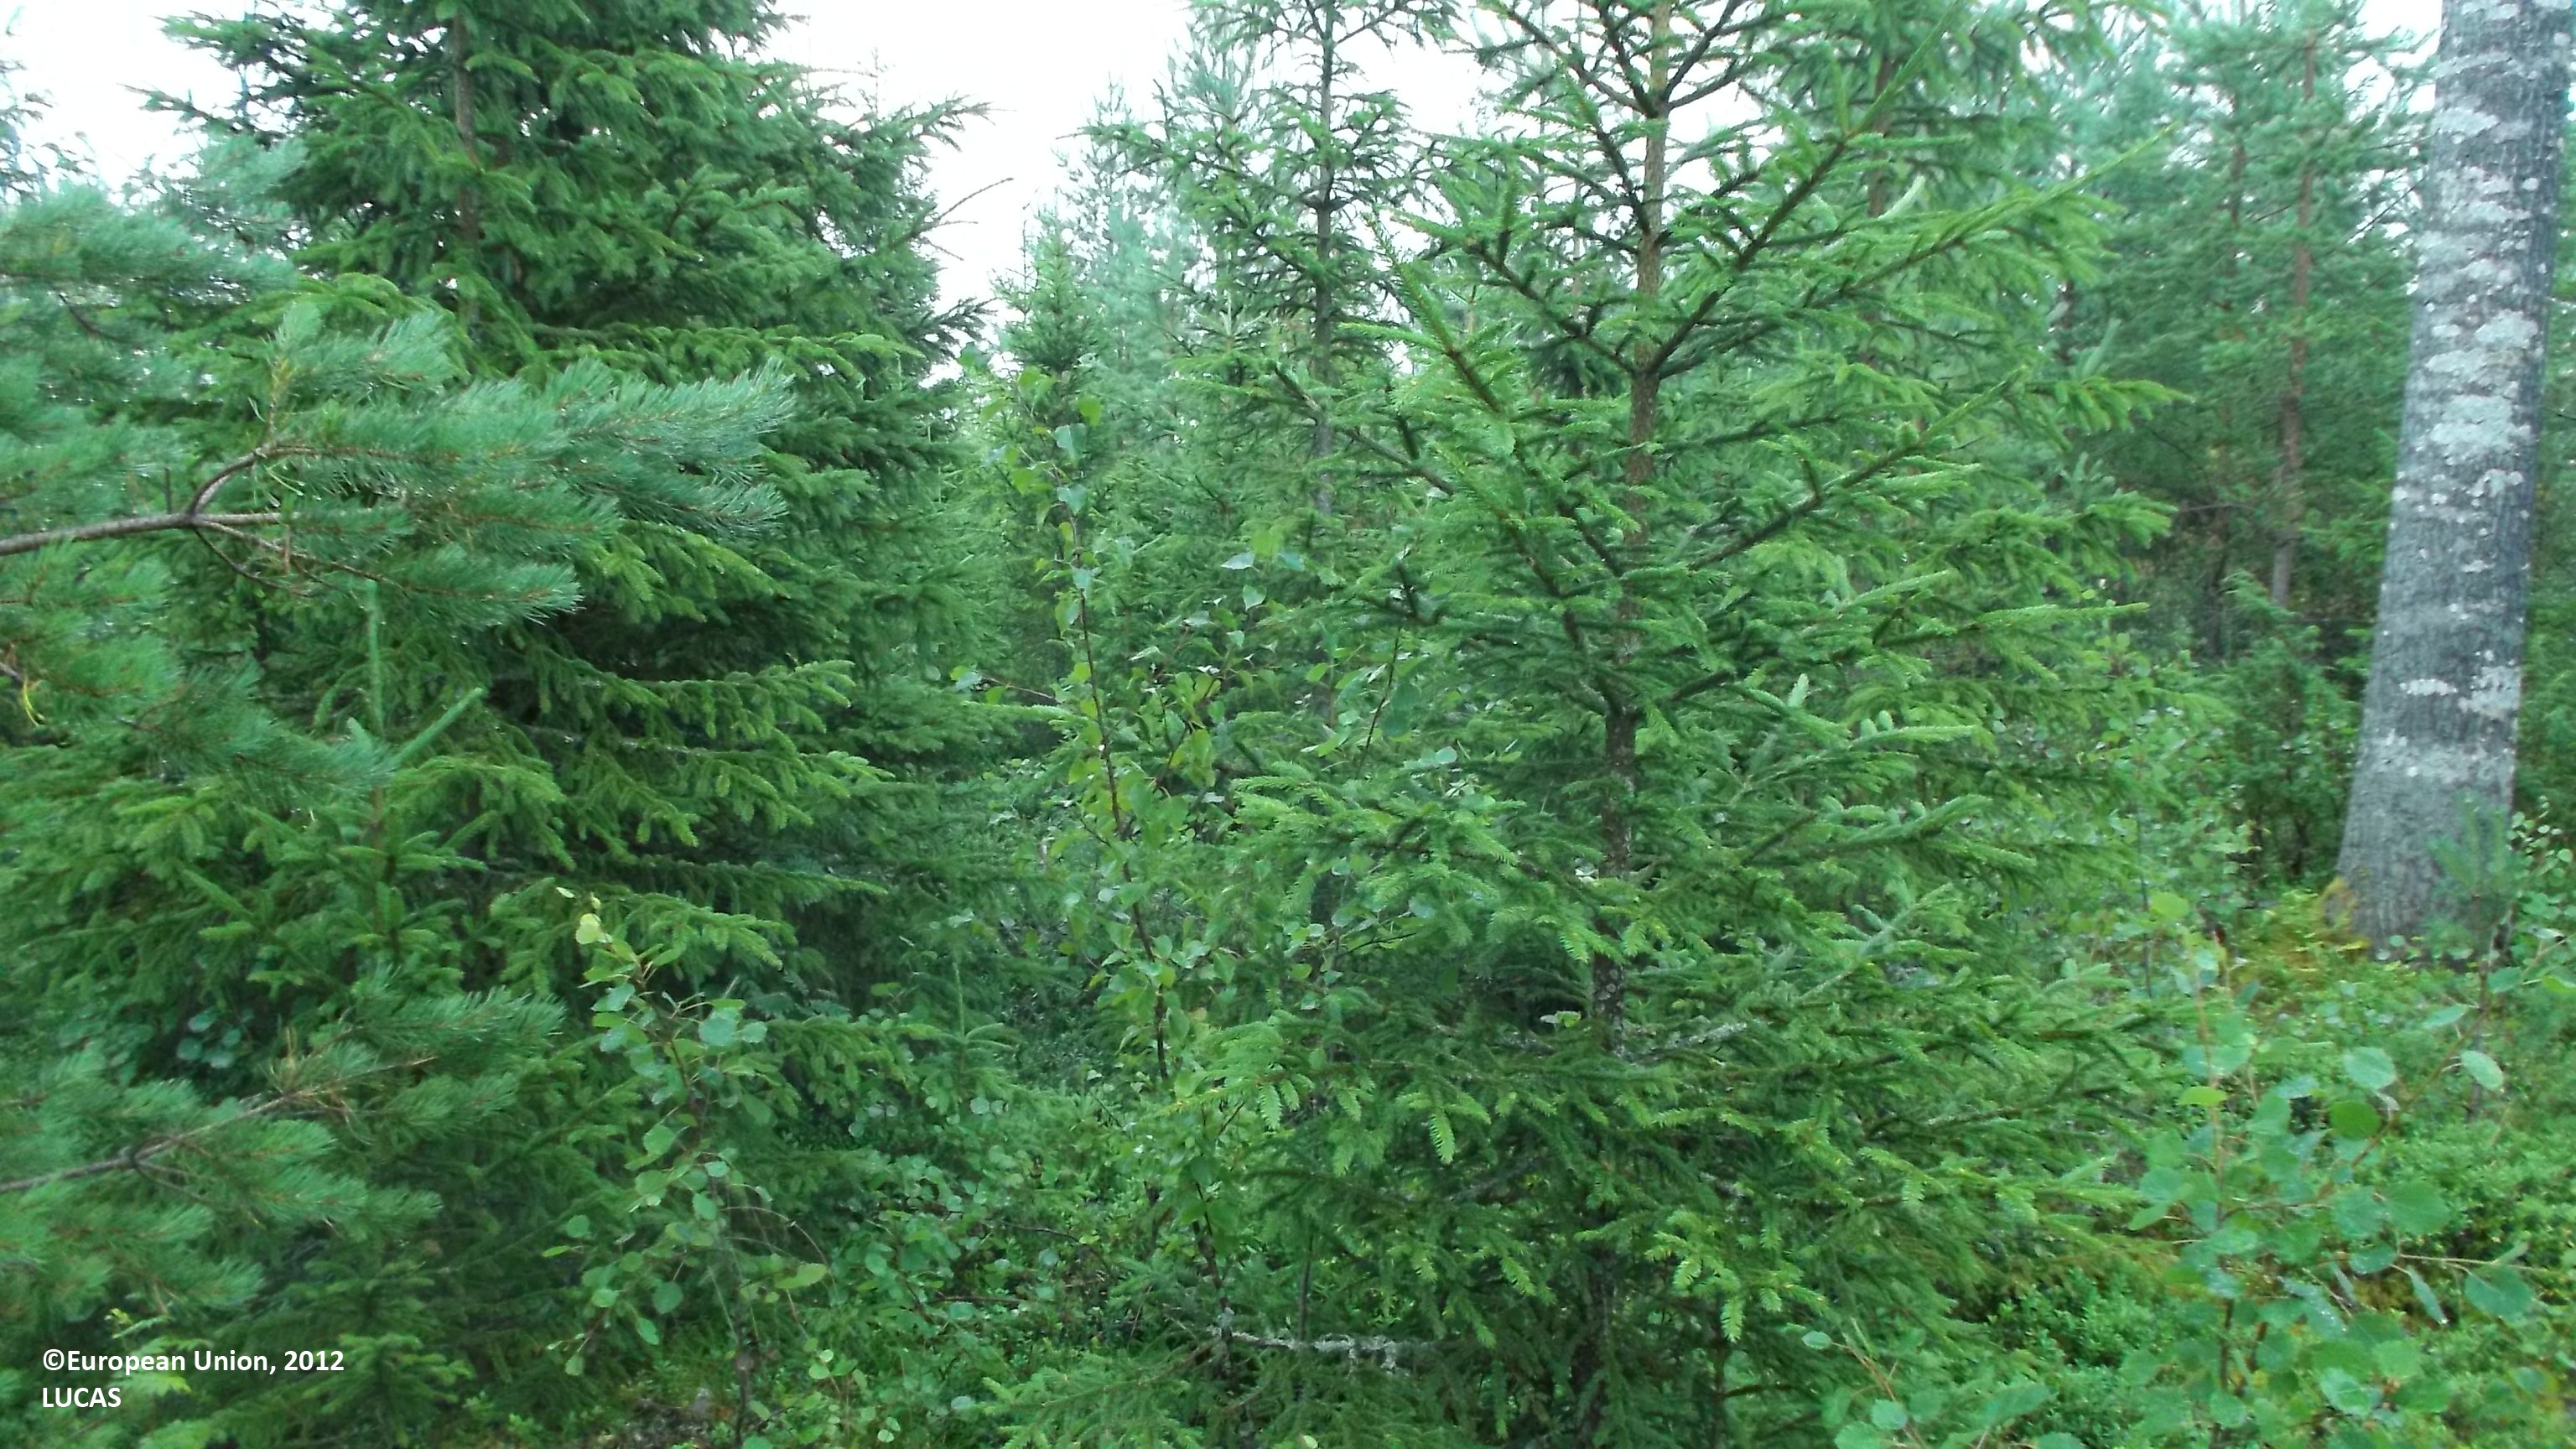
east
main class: Woodland
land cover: Other mixed woodland
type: boreal forest
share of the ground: 50 - 75 %
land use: Forestry
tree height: > 5 m
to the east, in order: Other mixed woodland; Ditches and canals; Abandoned hedges; Tracks; Other mixed woodland; Pine dominated coniferous woodland; Pine dominated mixed woodland; Other mixed woodland; Broadleaved woodland; Ditches and canals; Barley; Ditches and canals; Pine dominated mixed woodland
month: August
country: FI
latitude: 63.7362
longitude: 22.9539
